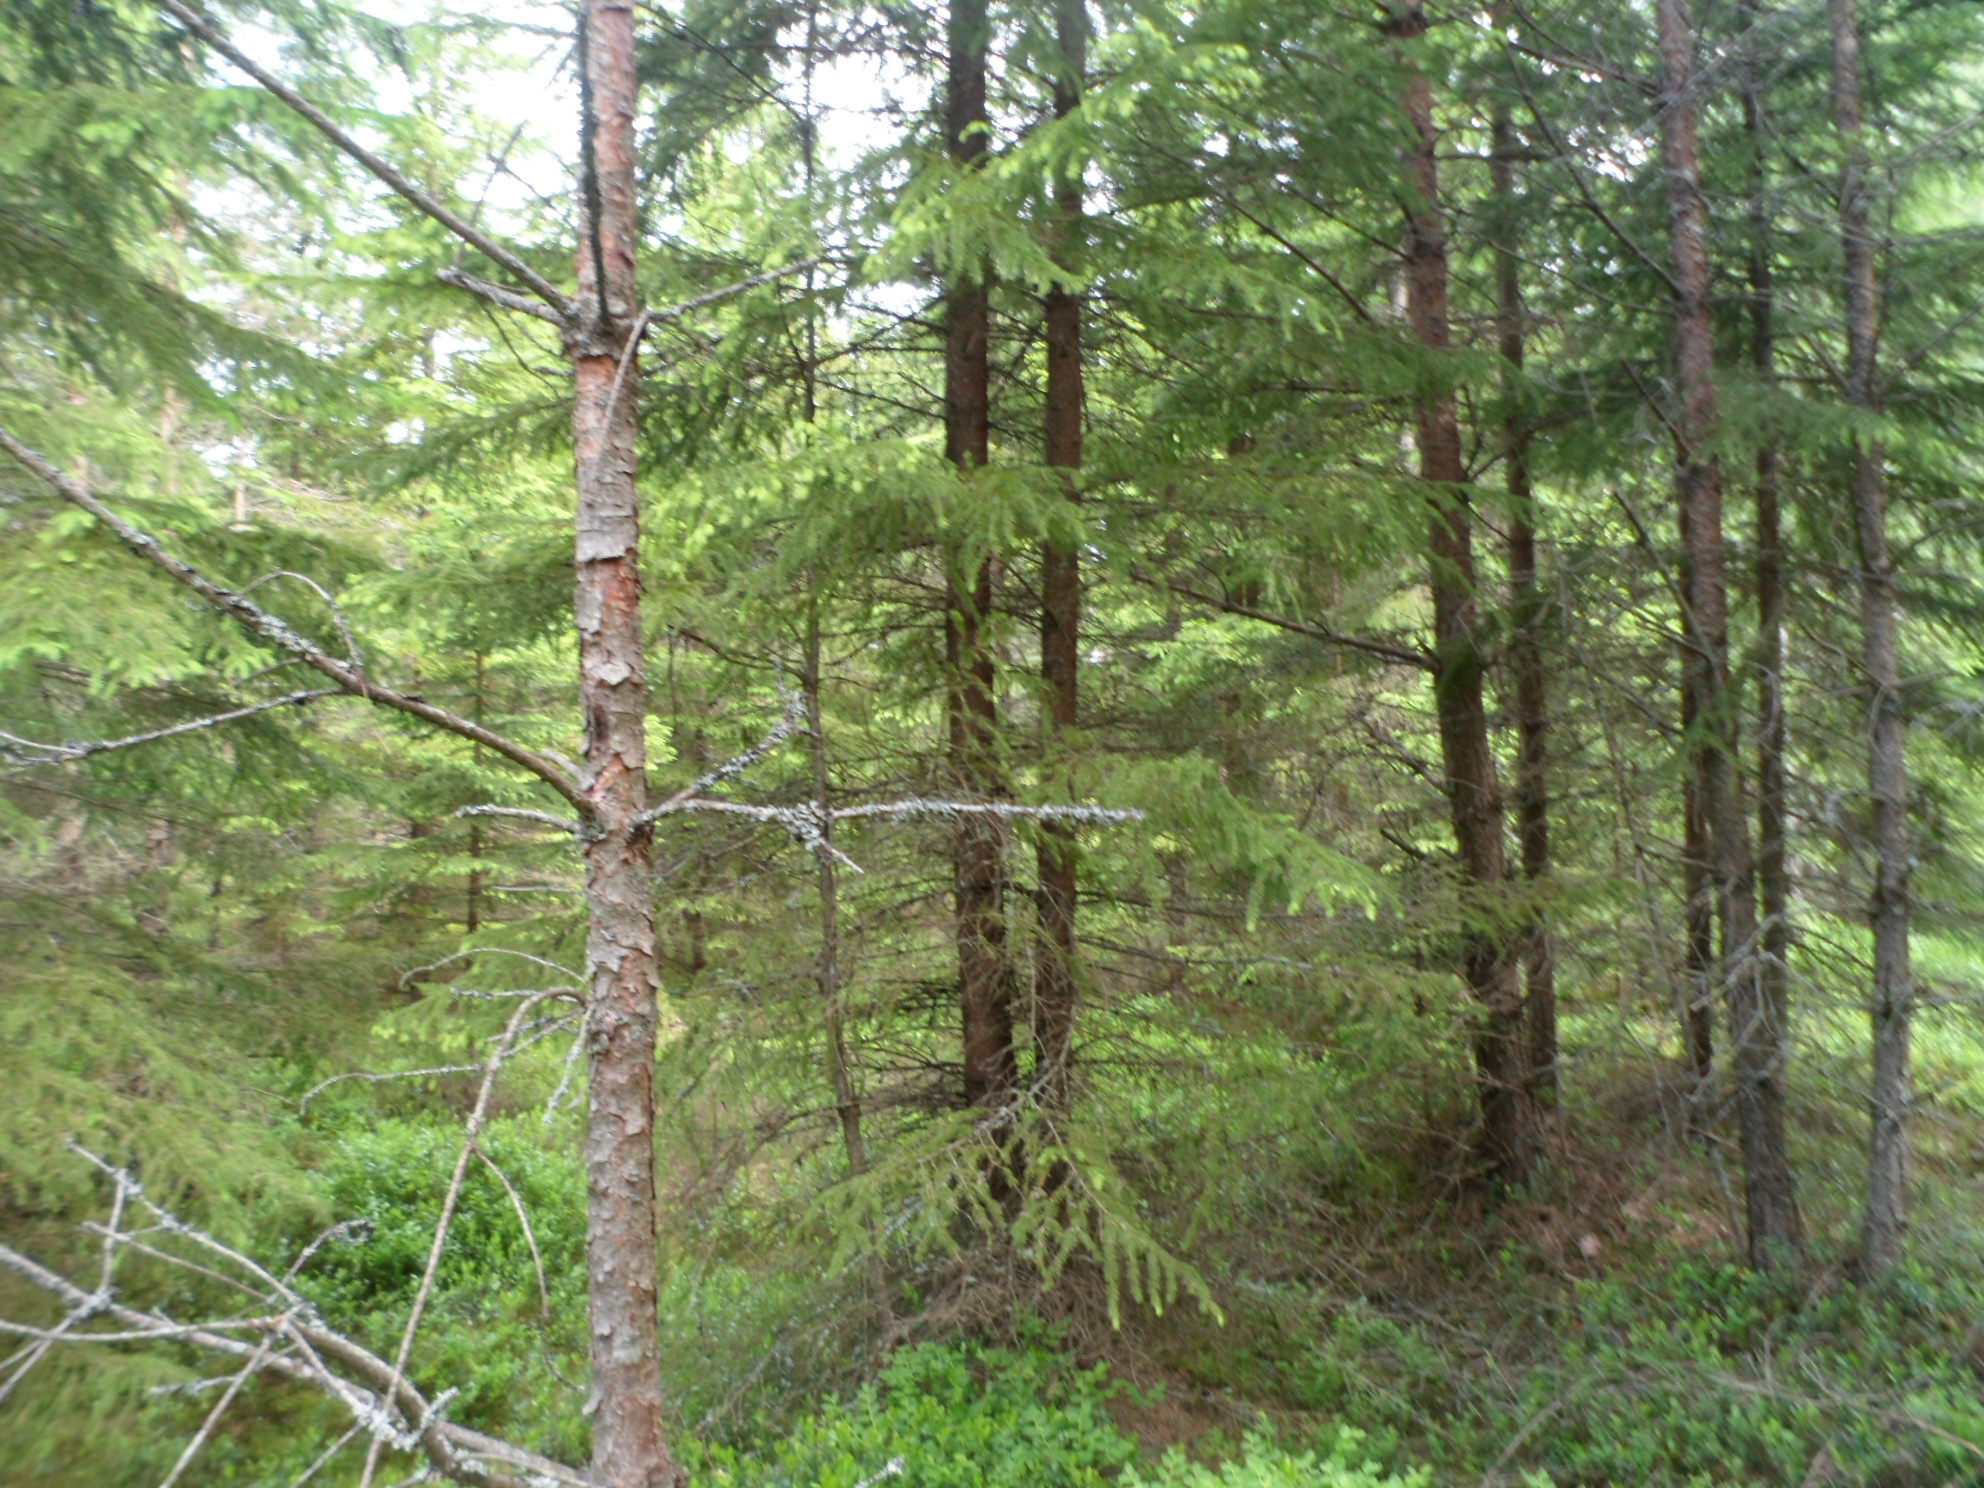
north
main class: Woodland
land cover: Pine dominated coniferous woodland
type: boreal forest
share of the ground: 50 - 75 %
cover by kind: coniferous forest trees 70 %, shrubs 15 %, lichens and mosses 10 %, herbaceous plants 5 %
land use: Forestry
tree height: > 5 m
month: June
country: SE
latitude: 57.0161
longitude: 15.2843
